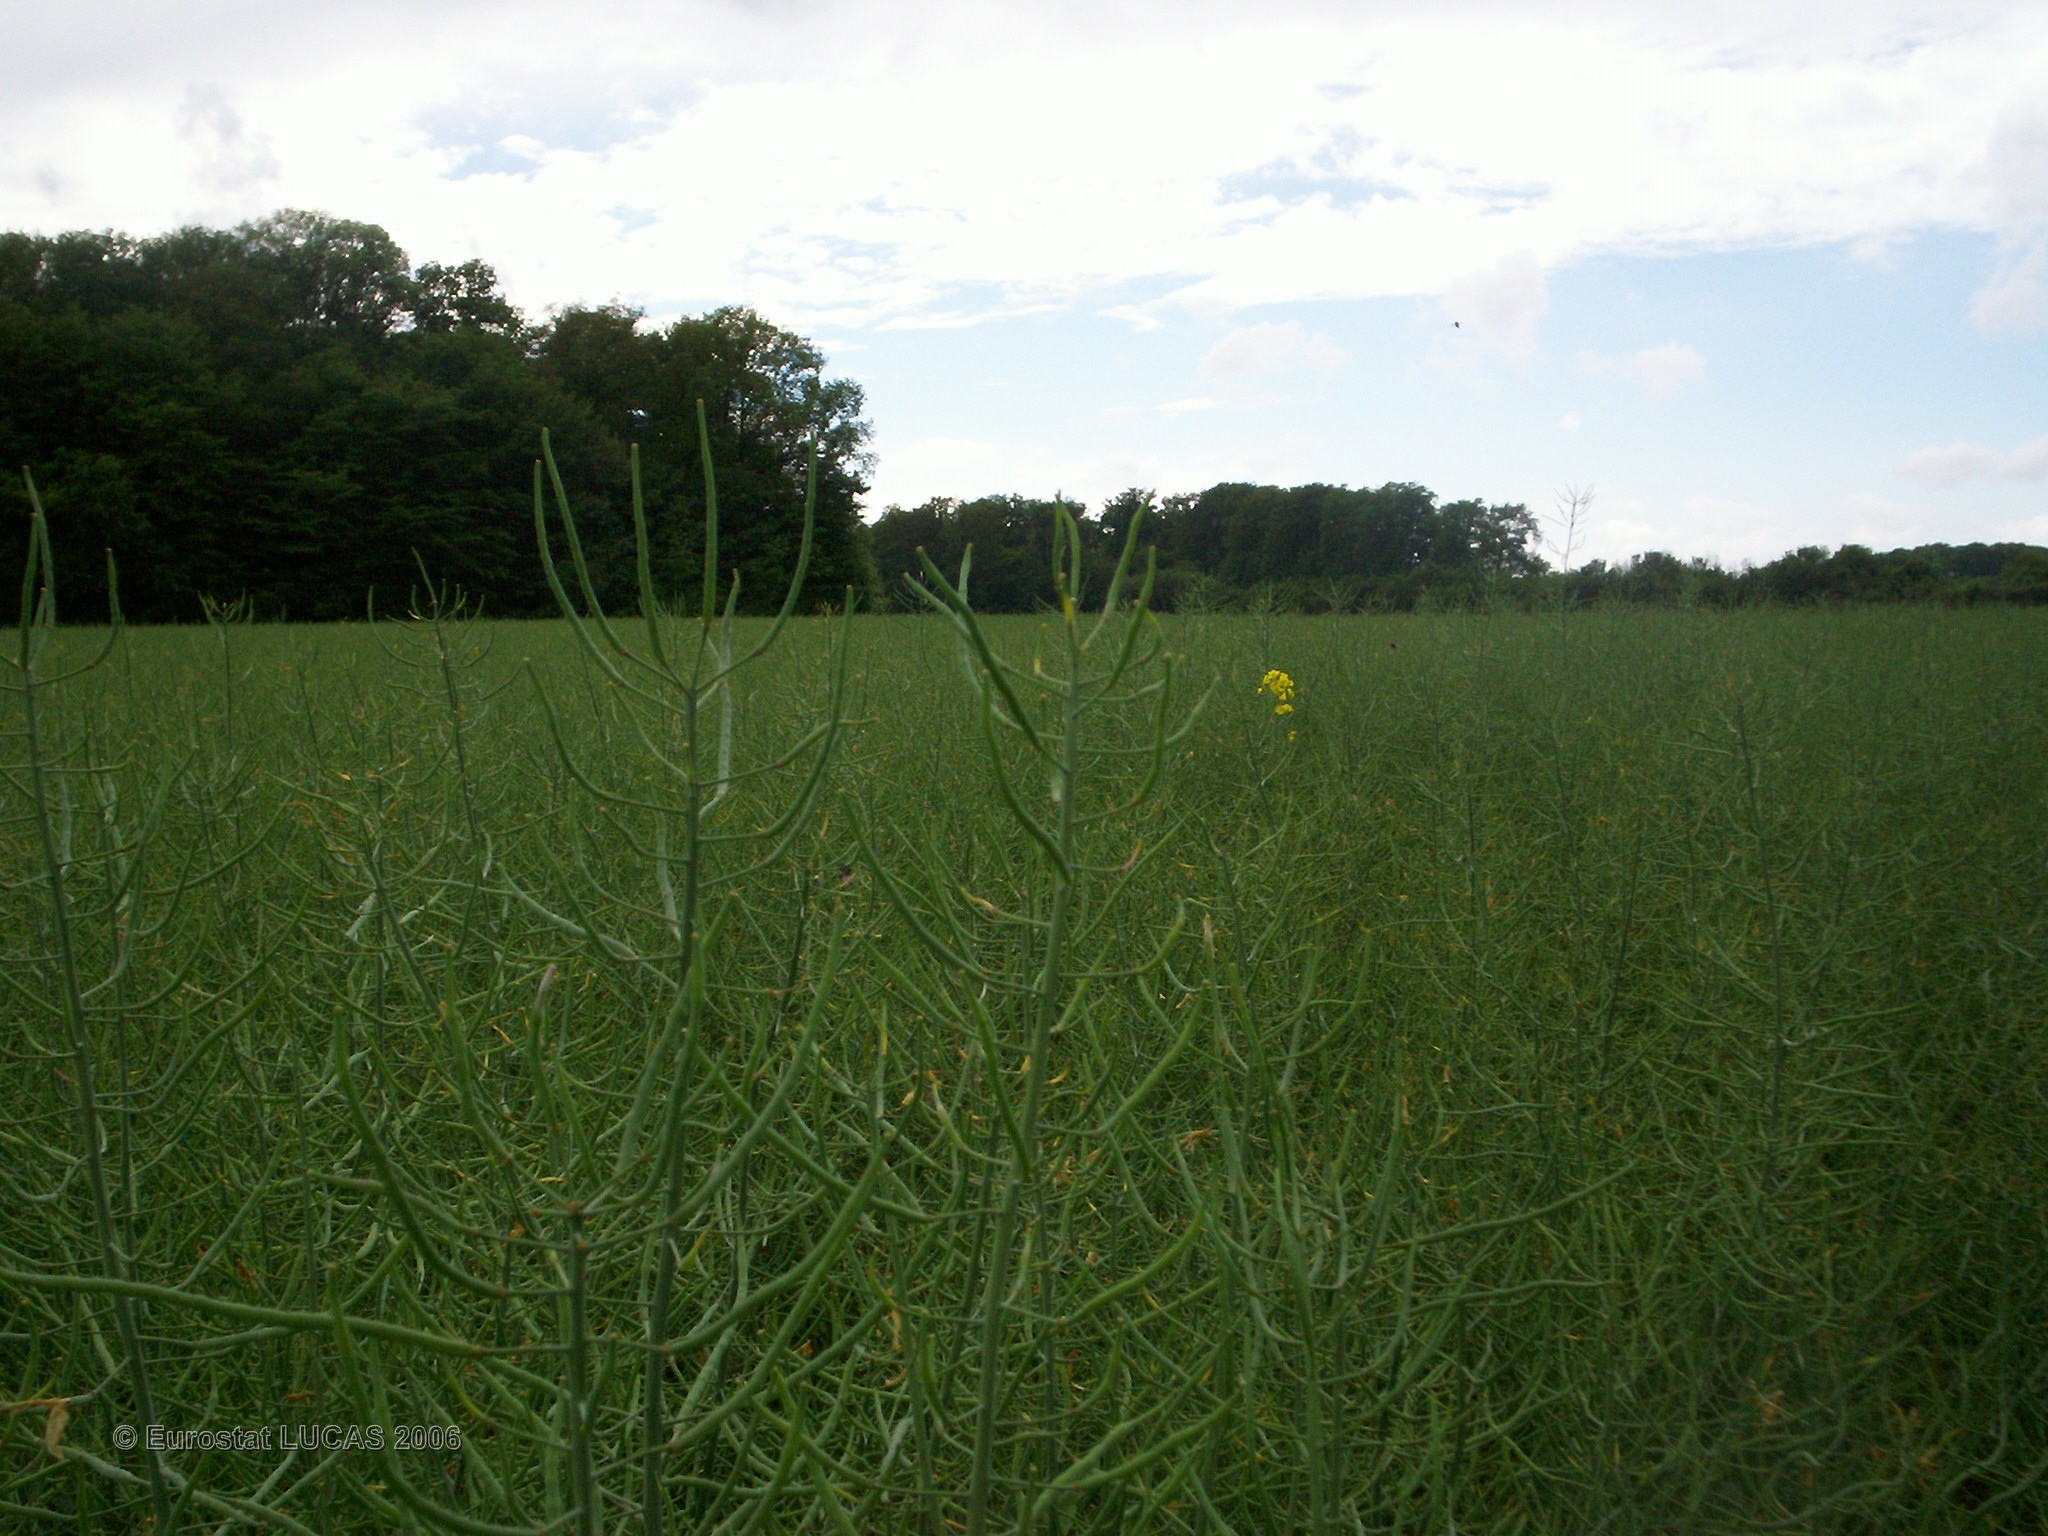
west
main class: Cropland
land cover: Rape and turnip rape
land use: Agriculture (excluding fallow land and kitchen gardens)
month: May
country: FR
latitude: 47.7833
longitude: 2.9863
